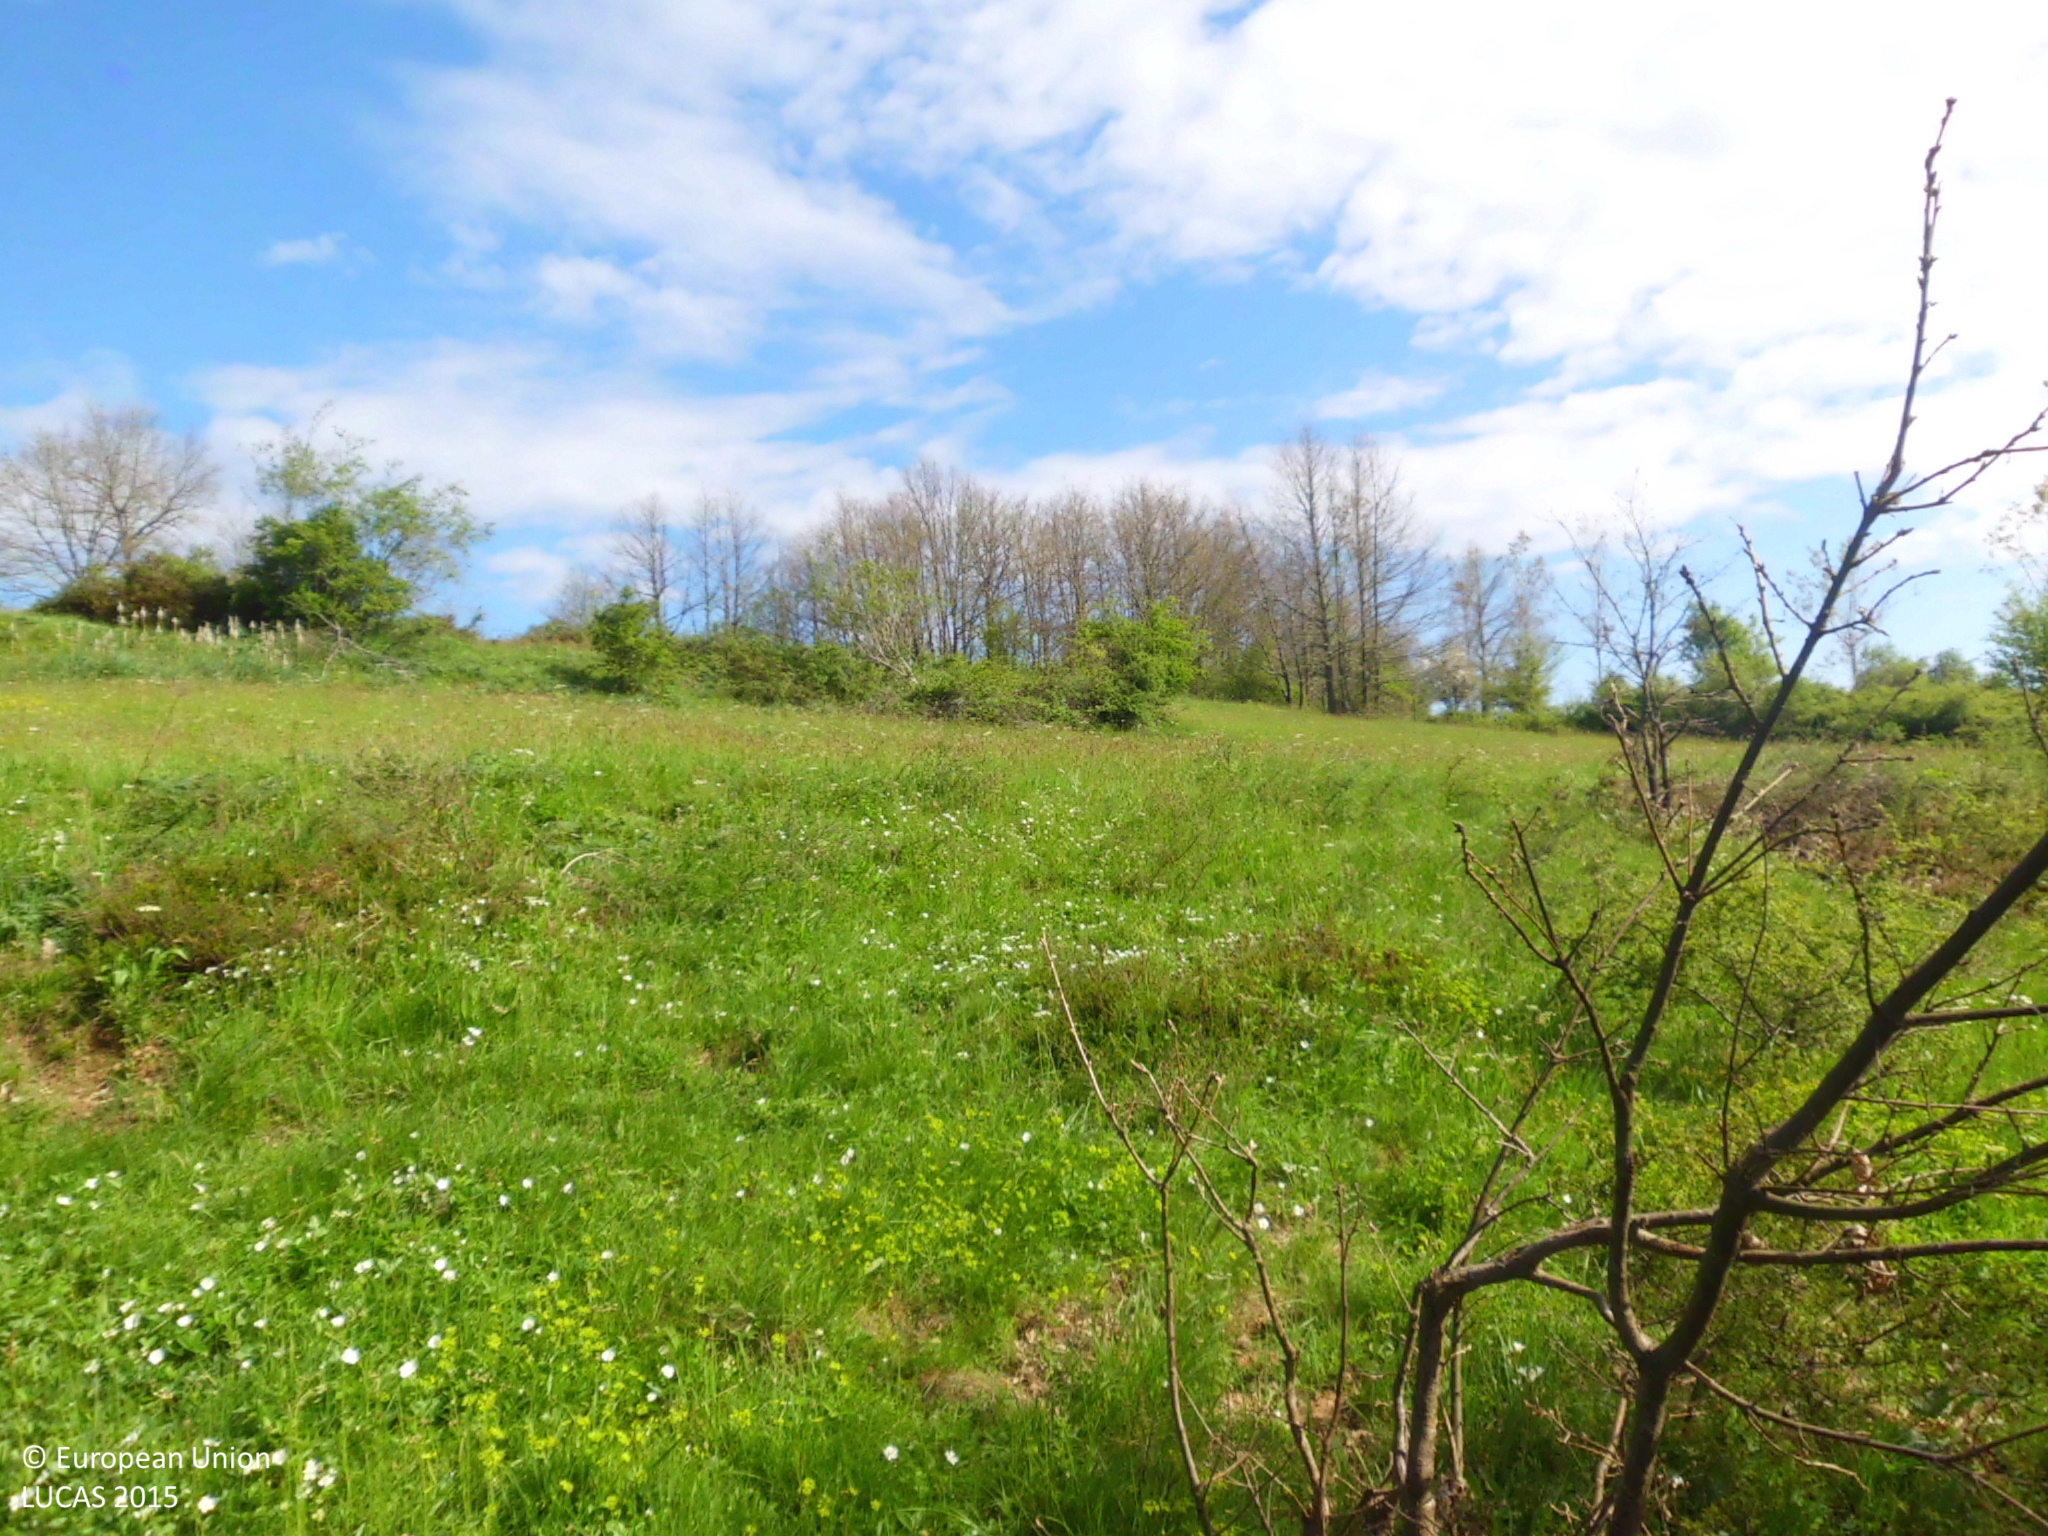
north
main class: Grassland
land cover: Grassland with sparse tree/shrub cover
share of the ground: 25 - 50 %
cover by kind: herbaceous plants 90 %, broadleaved forest trees 5 %, shrubs 5 %
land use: Abandoned areas
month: May
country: ES
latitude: 42.8950
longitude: -3.9201
